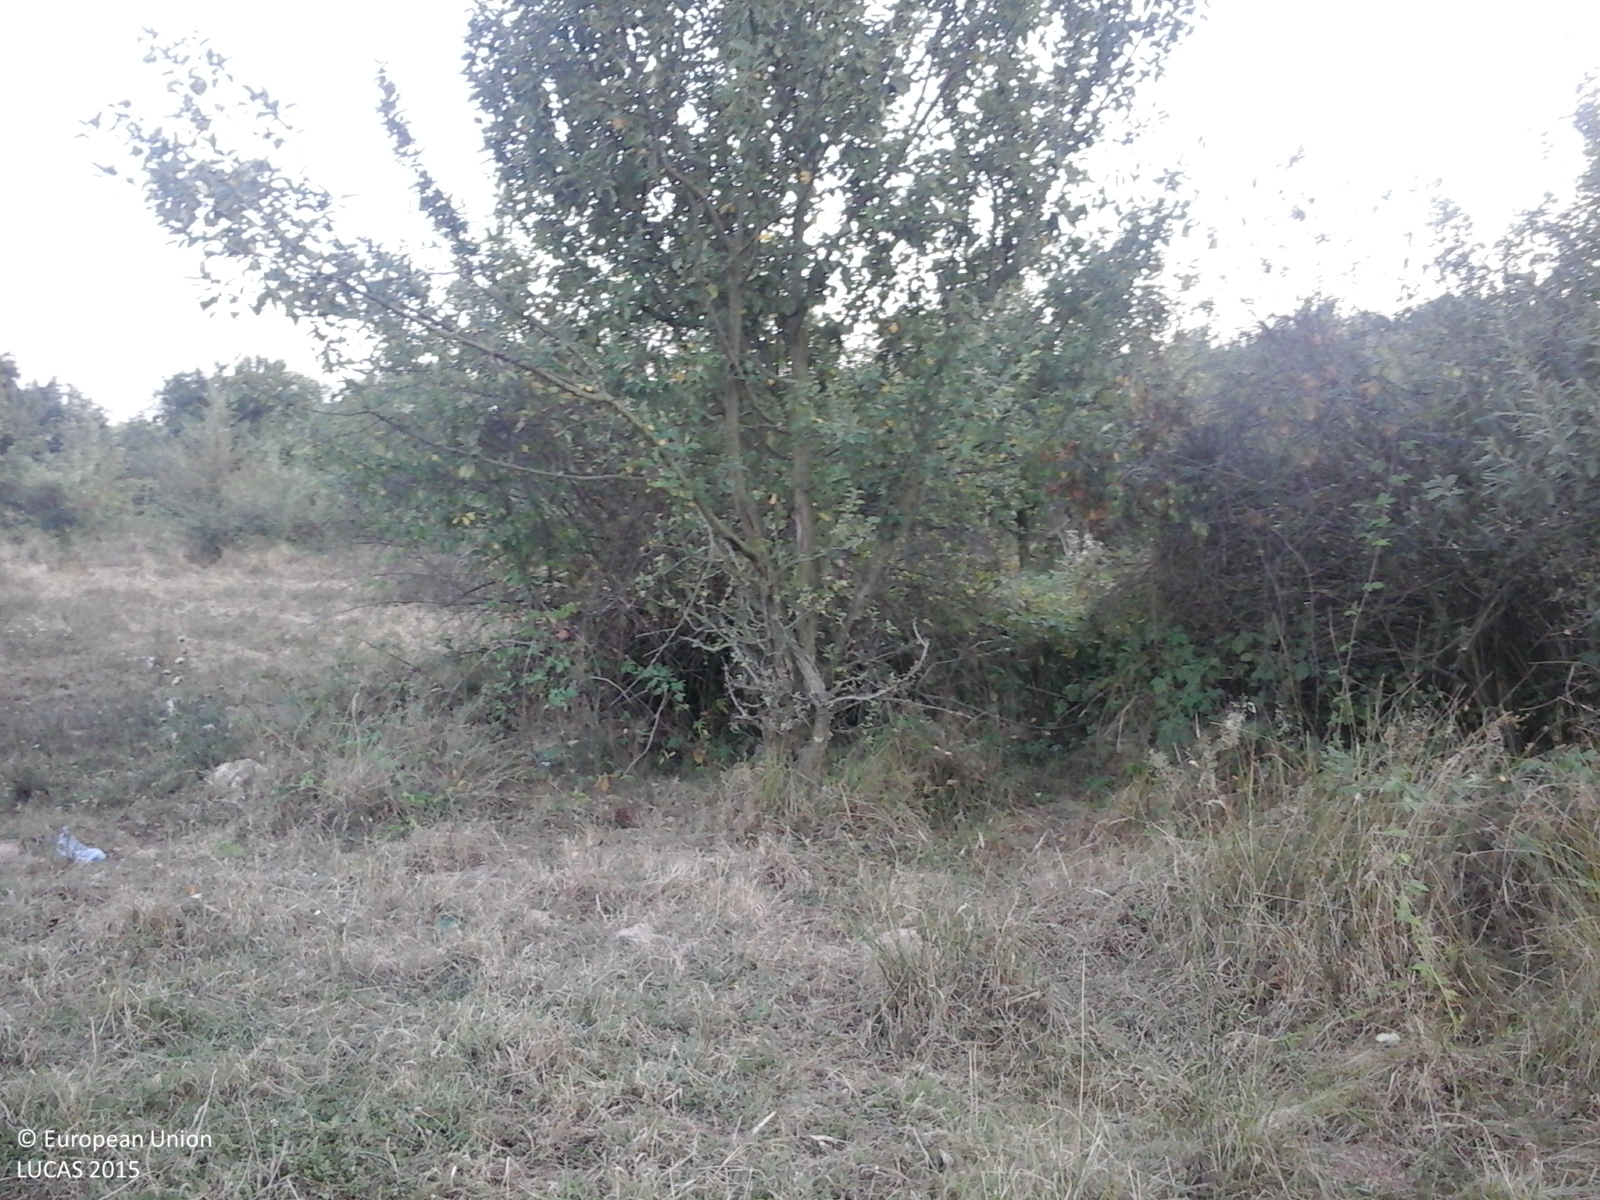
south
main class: Grassland
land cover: Grassland with sparse tree/shrub cover
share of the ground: > 75 %
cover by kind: herbaceous plants 90 %, broadleaved forest trees 5 %, shrubs 5 %
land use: Agriculture (excluding fallow land and kitchen gardens)
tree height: < 5 m
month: September
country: RO
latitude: 47.6691
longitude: 23.2958
